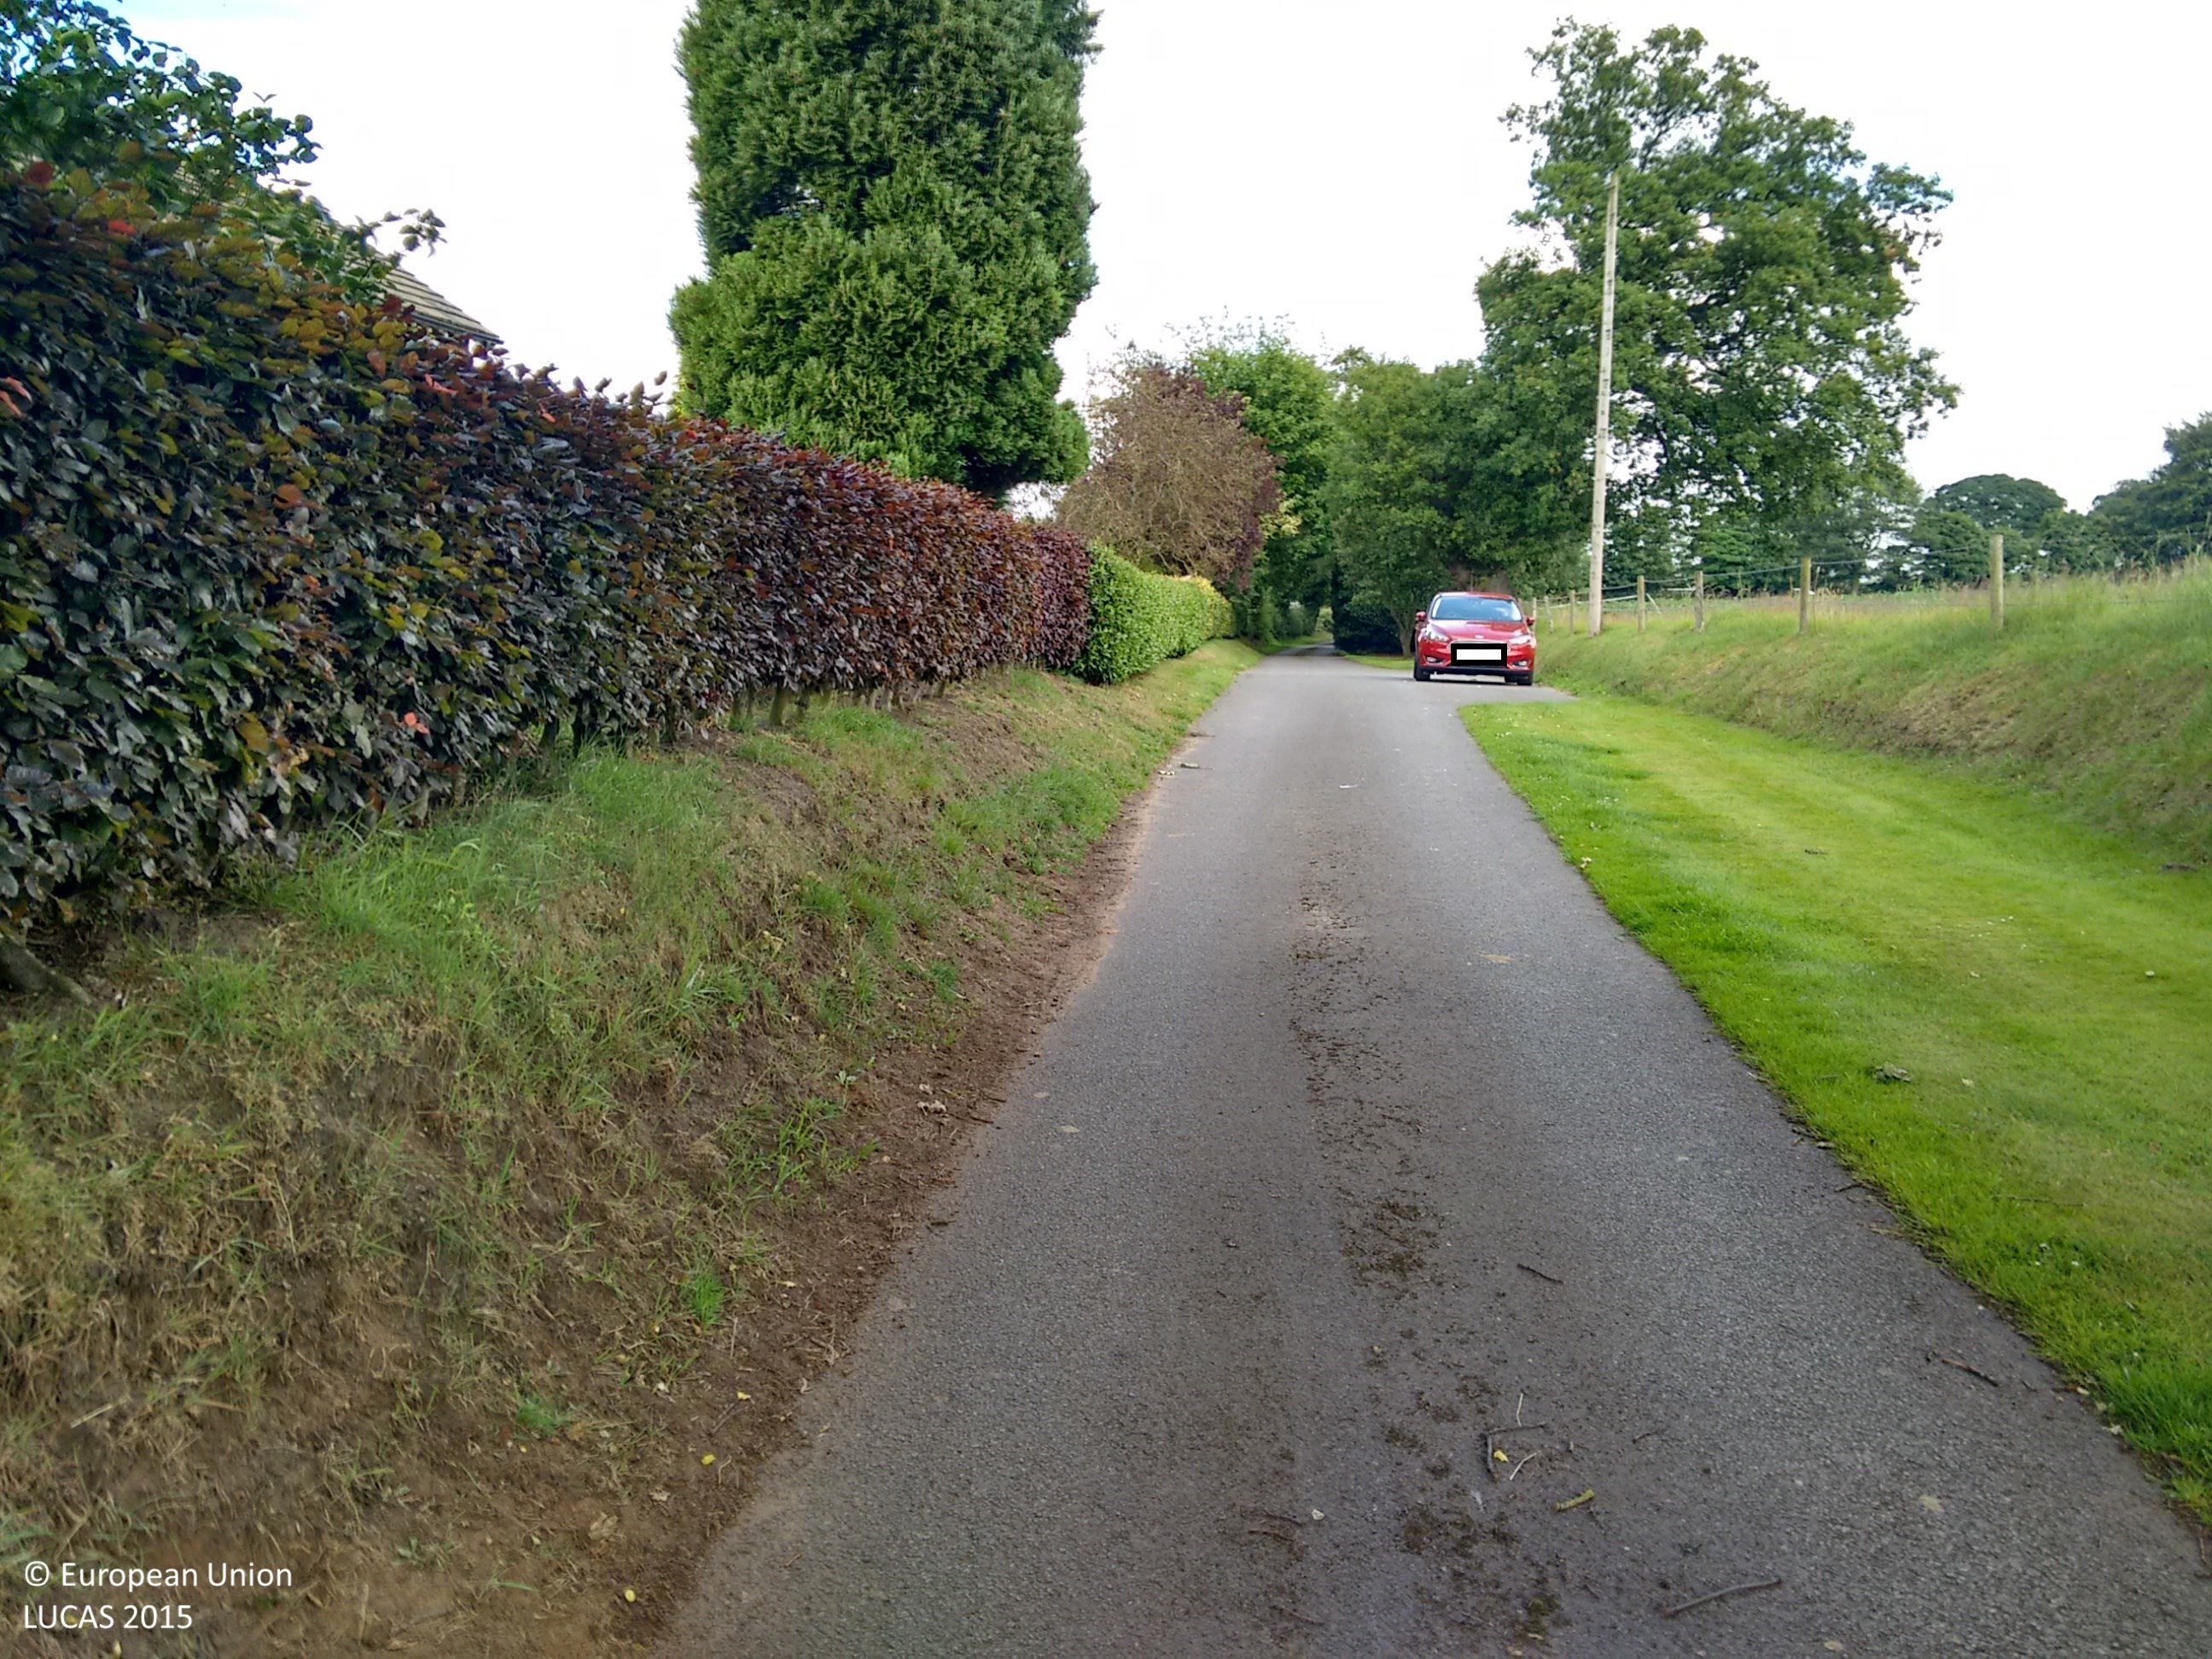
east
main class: Cropland
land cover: Dry pulses
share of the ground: > 75 %
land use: Agriculture (excluding fallow land and kitchen gardens)
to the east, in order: Dry pulses
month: July
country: GB
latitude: 53.2152
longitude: -2.2363
